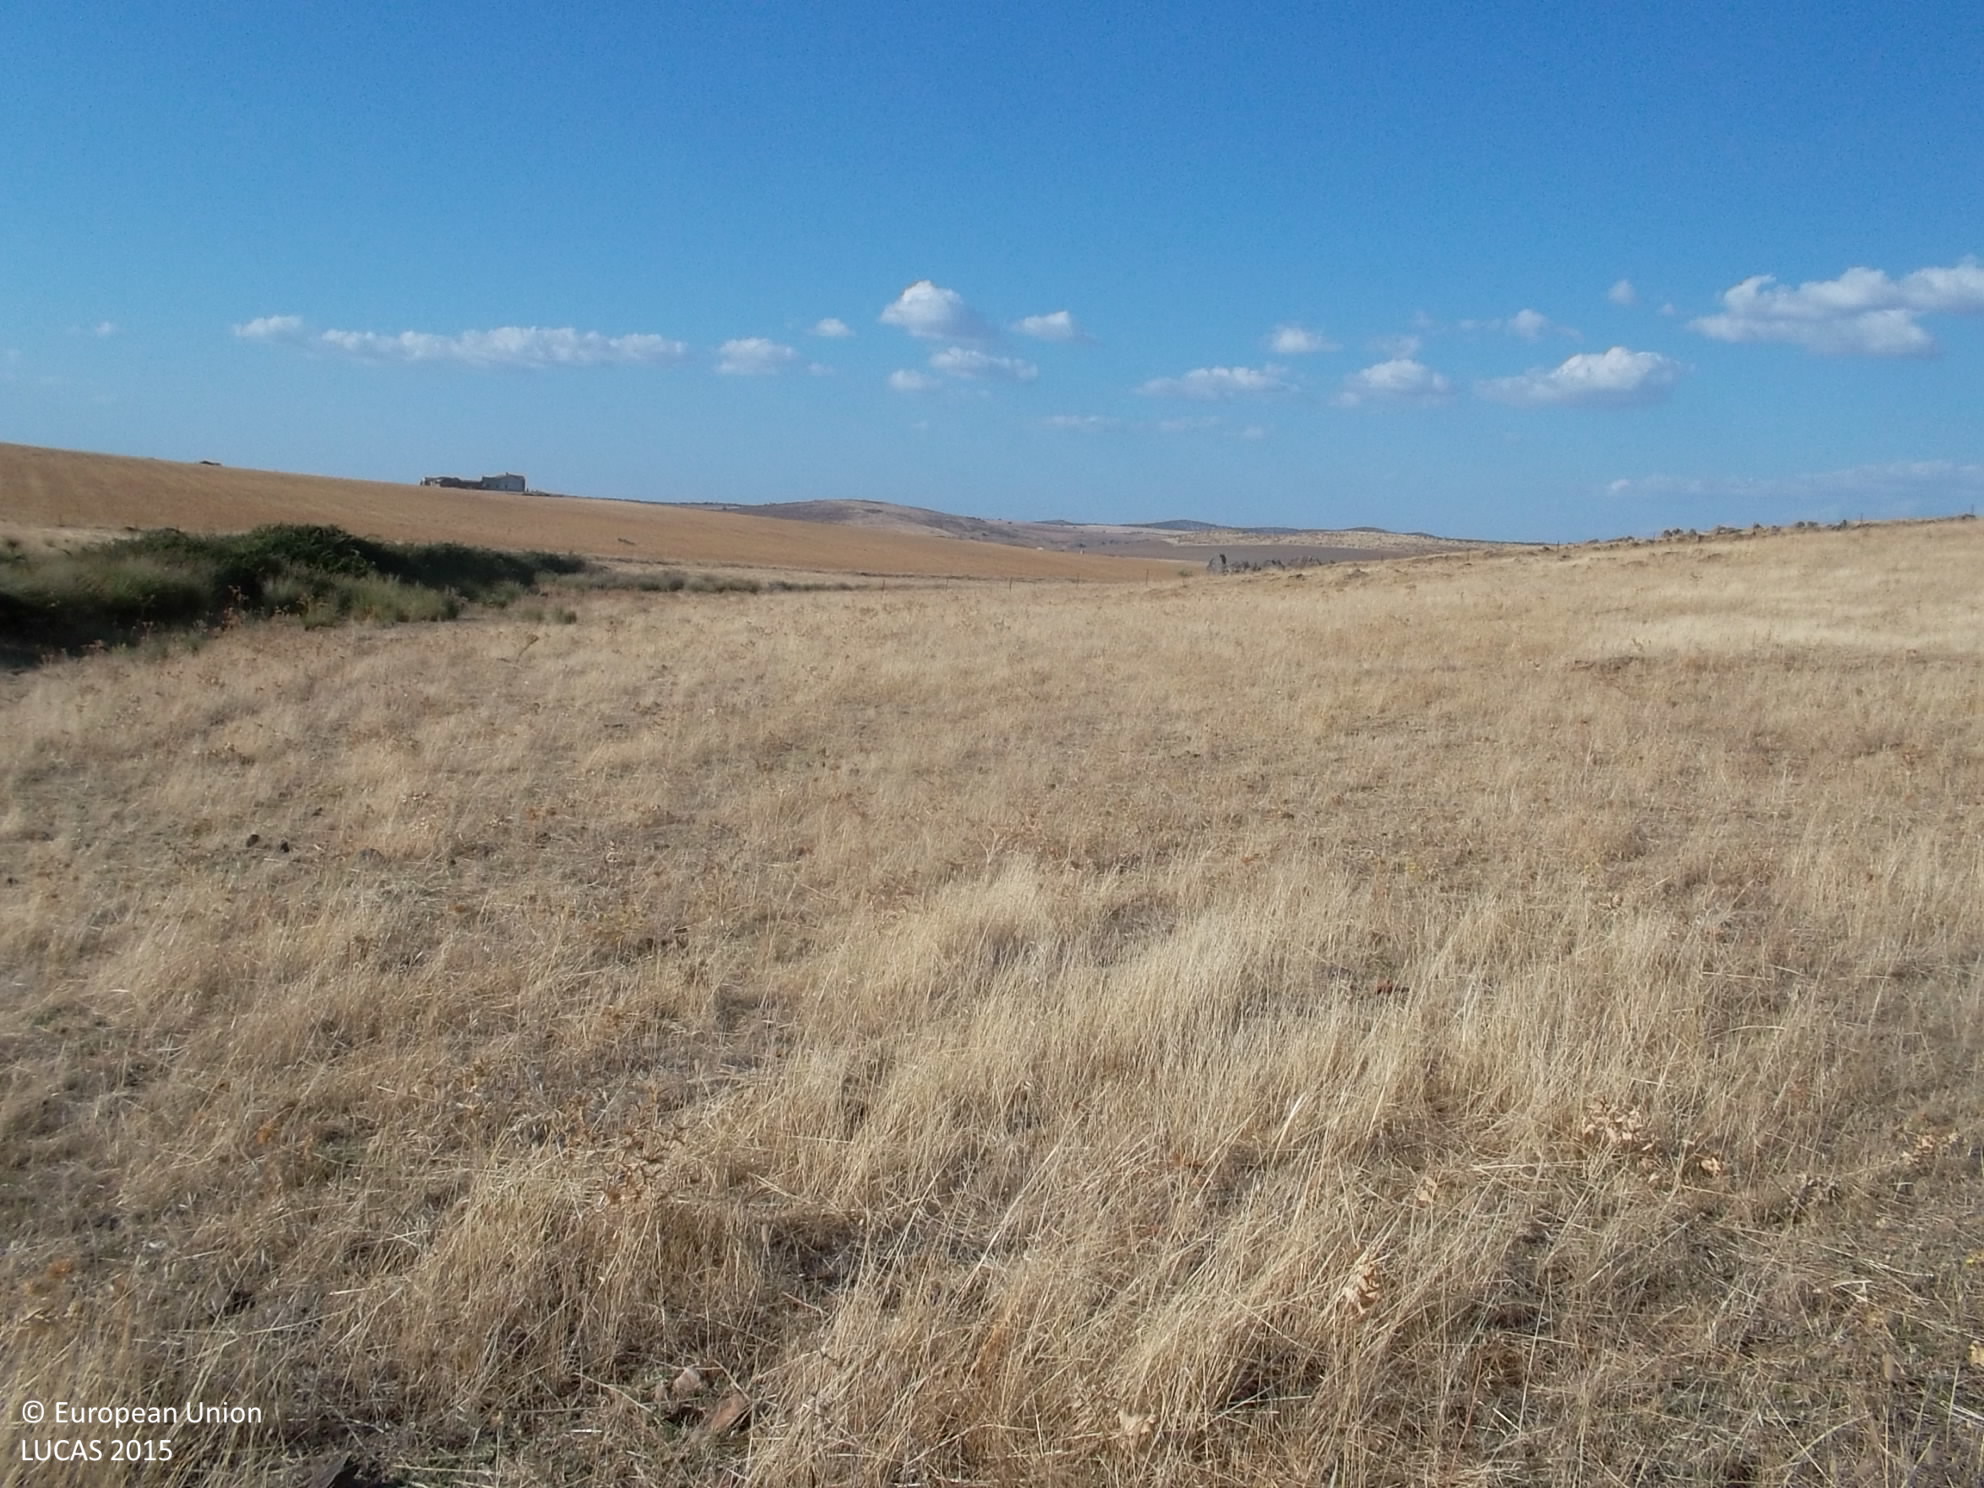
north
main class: Grassland
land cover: Spontaneously vegetated surfaces
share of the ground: > 75 %
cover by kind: herbaceous plants 100 %
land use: Fallow land
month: September
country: ES
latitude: 38.2365
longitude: -6.3722
